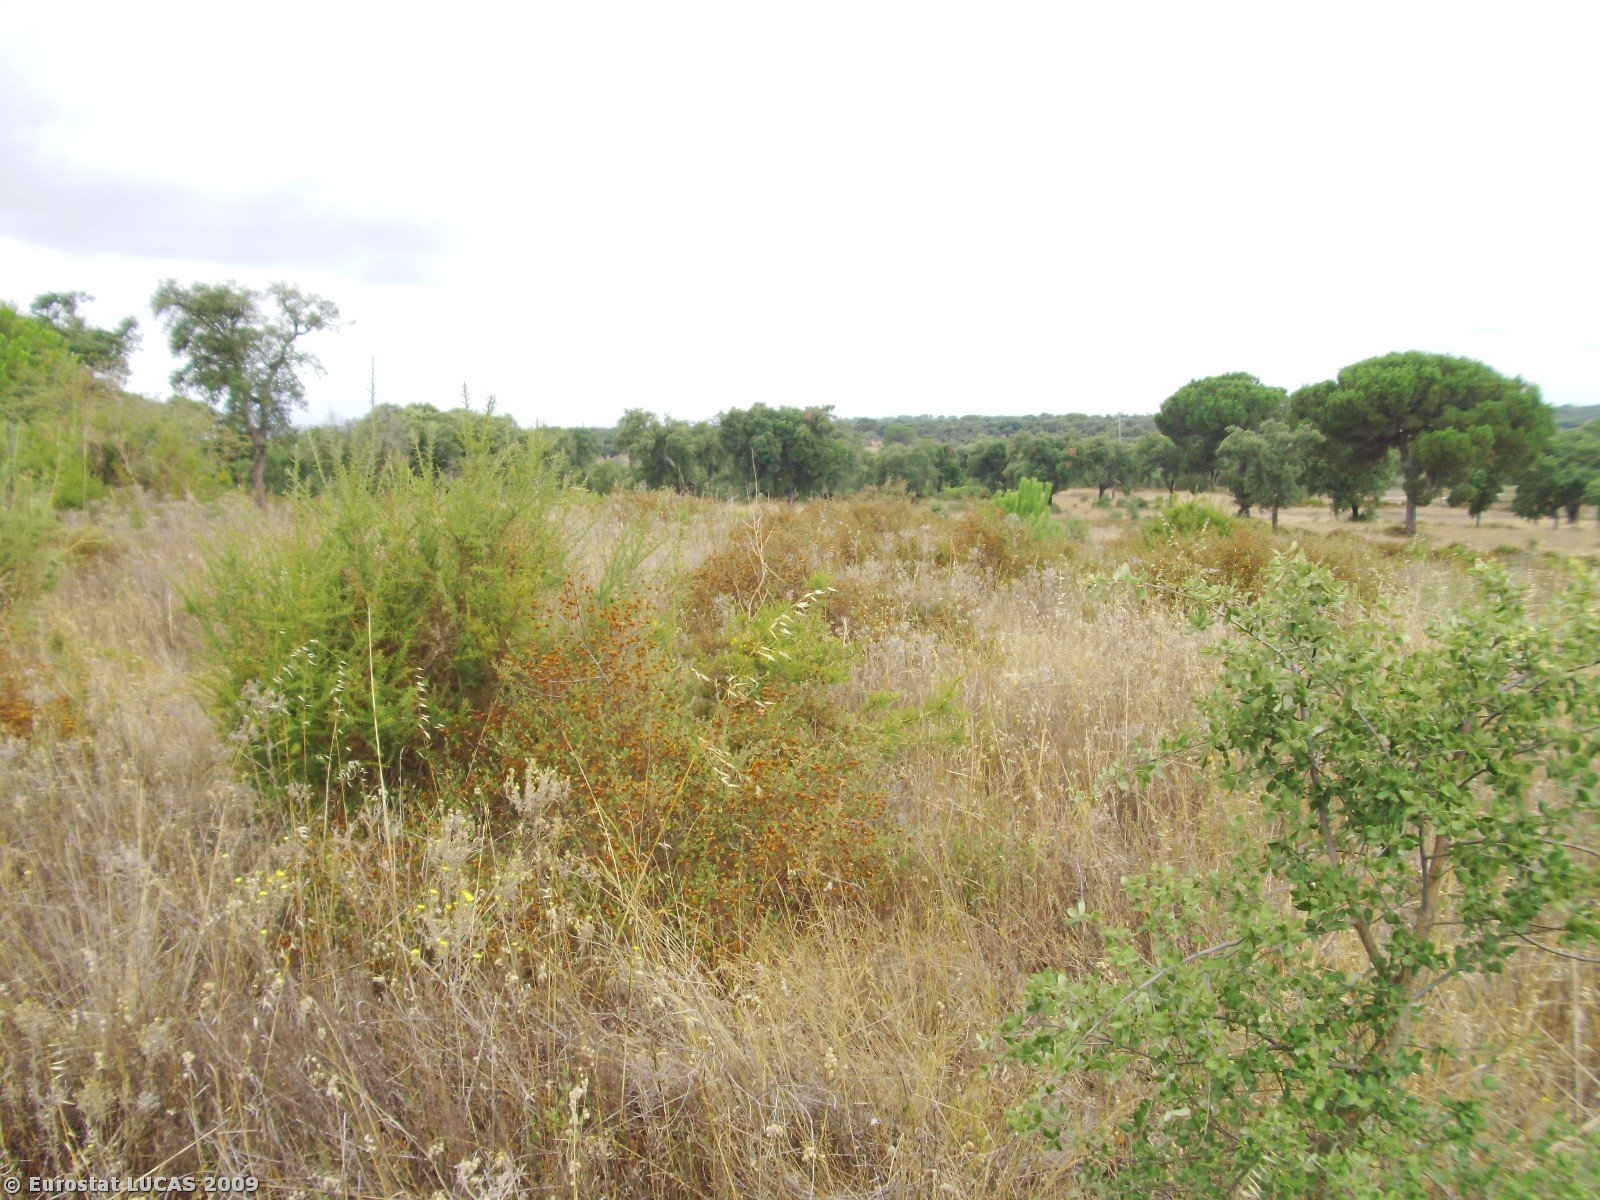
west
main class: Grassland
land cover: Spontaneously vegetated surfaces
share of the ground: > 75 %
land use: Fallow land
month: July
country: PT
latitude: 38.9373
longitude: -8.7698
